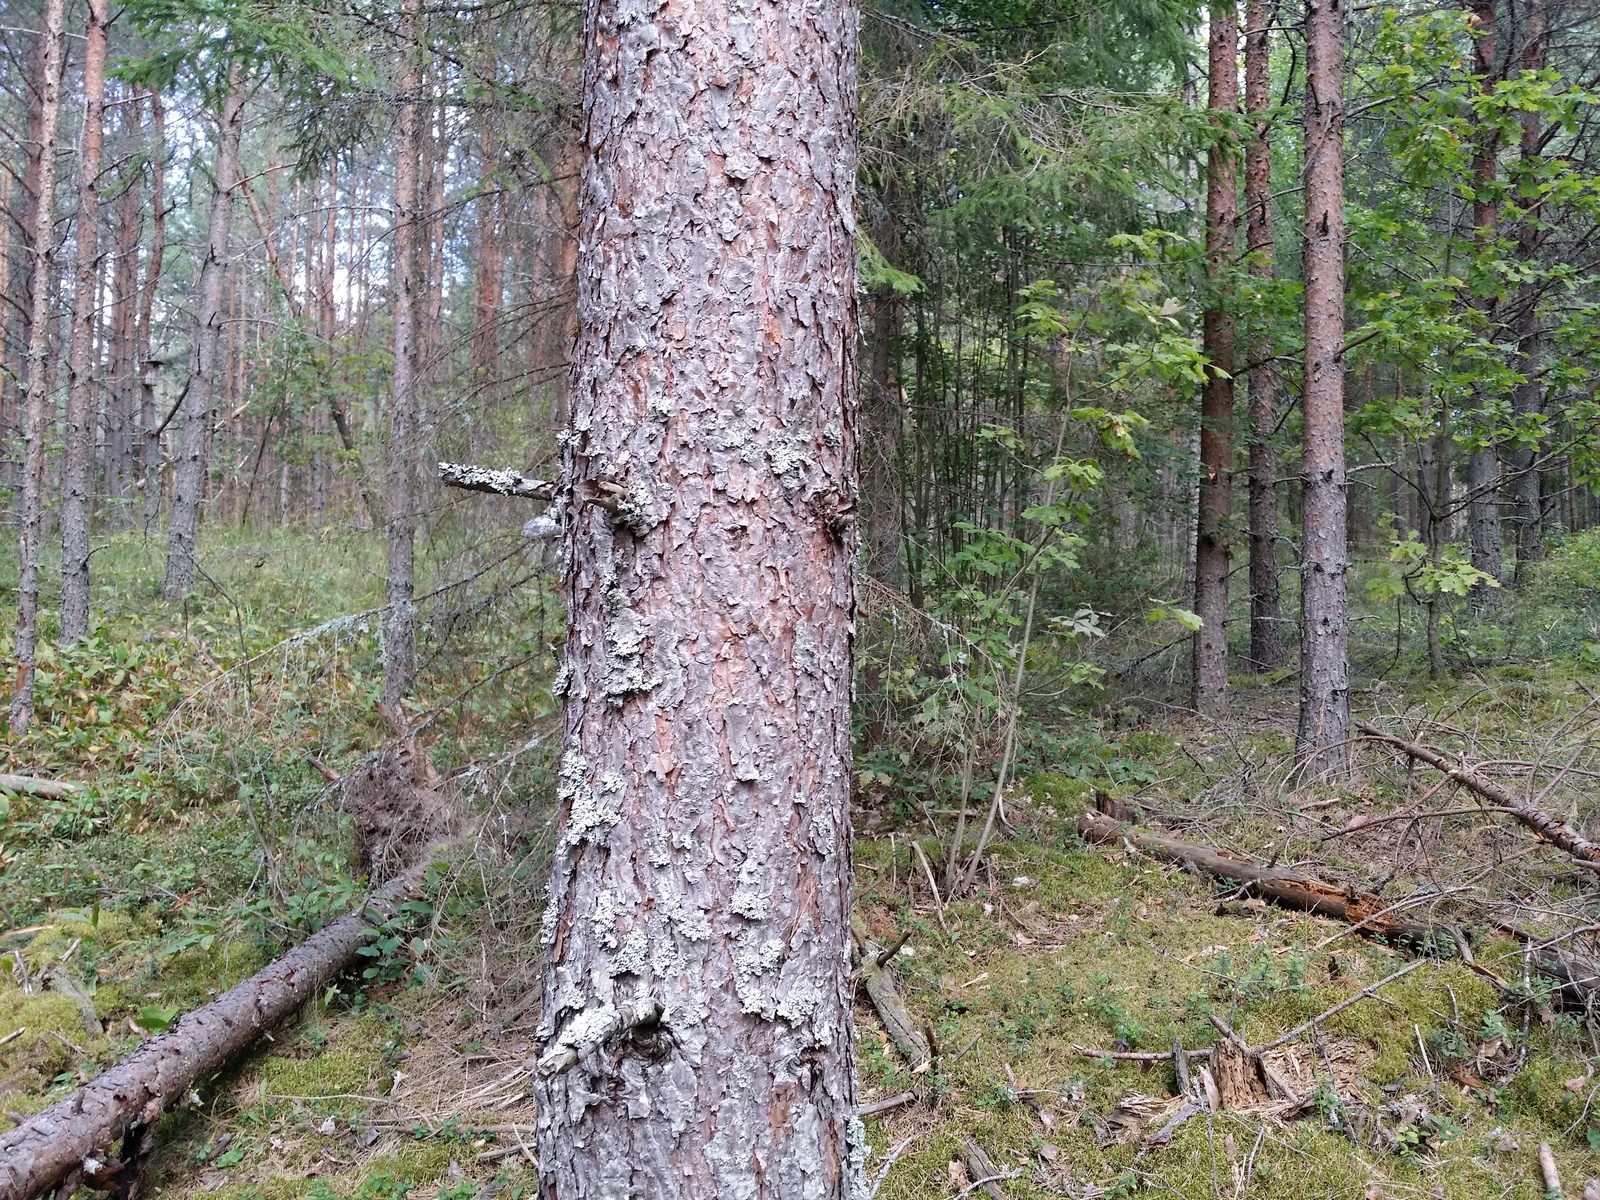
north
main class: Woodland
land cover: Other coniferous woodland
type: hemiboreal forest and nemoral coniferous forest and mixed broadleaved-coniferous forest
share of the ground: > 75 %
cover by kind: coniferous forest trees 80 %, shrubs 10 %, lichens and mosses 10 %
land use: Forestry
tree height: > 5 m
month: August
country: LV
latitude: 56.8737
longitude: 27.6223
